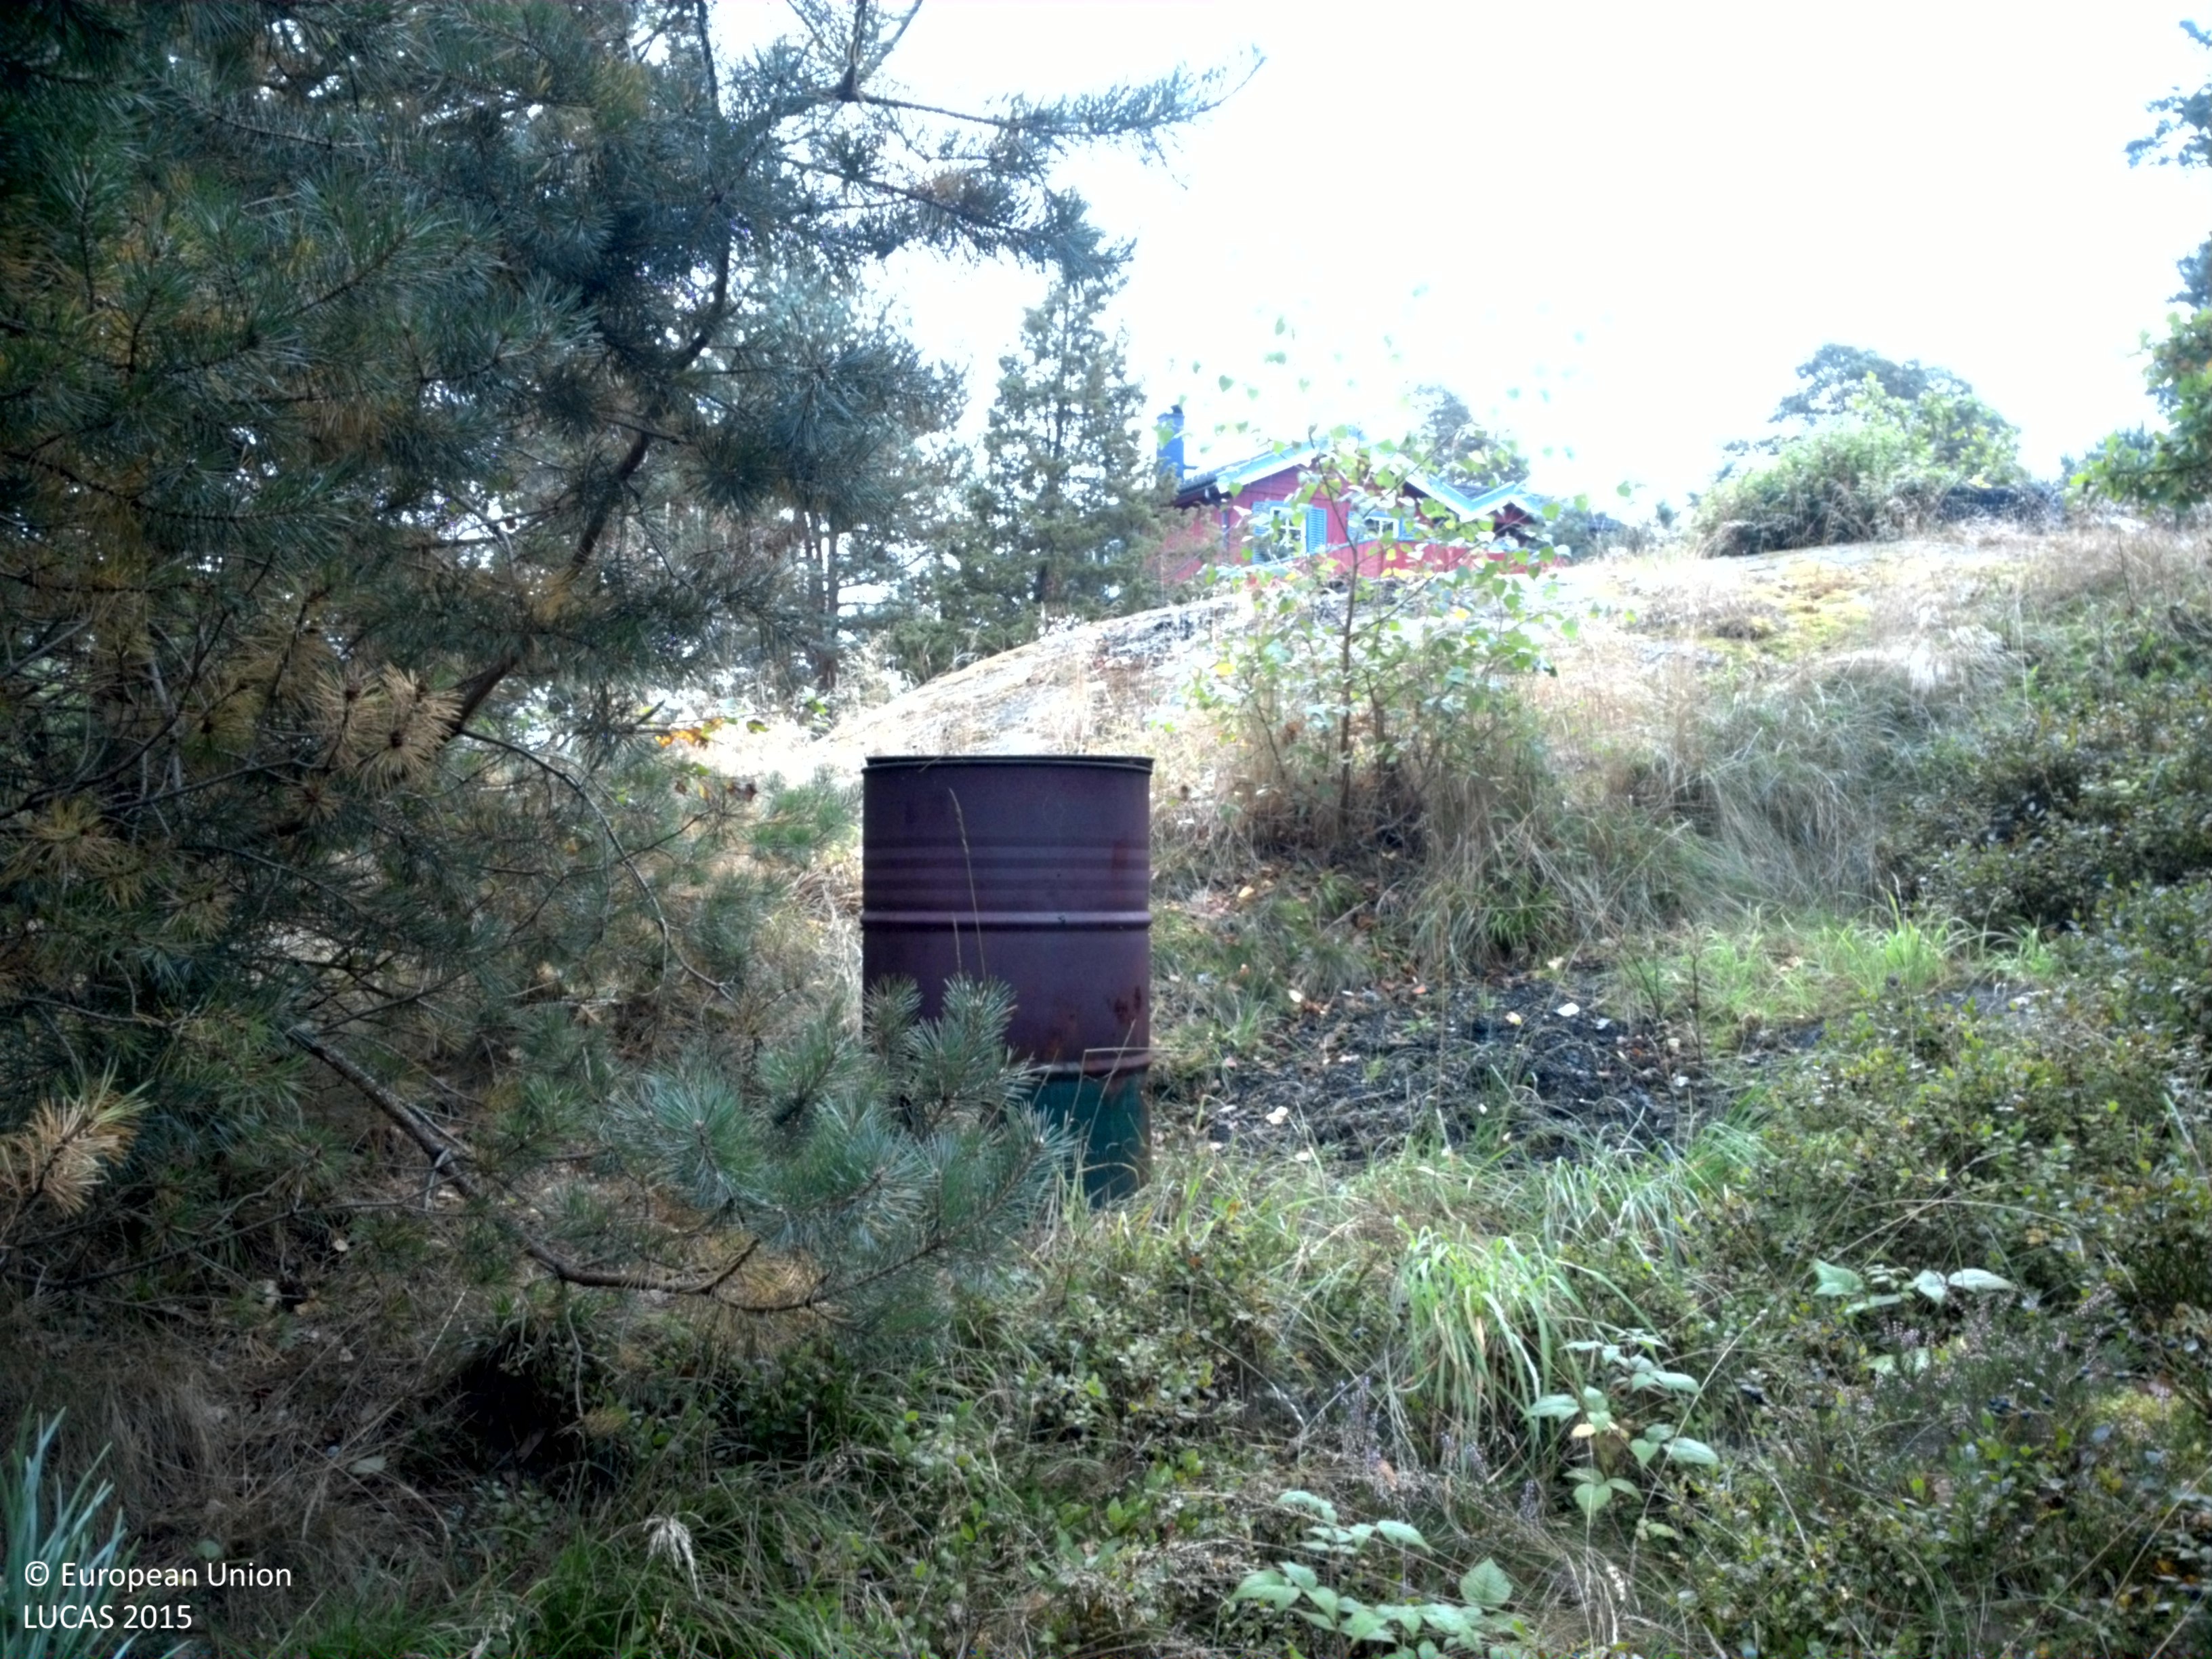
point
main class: Woodland
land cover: Pine dominated mixed woodland
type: boreal forest
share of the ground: < 10 %
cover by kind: lichens and mosses 35 %, consolidated bare surface 20 %, coniferous forest trees 15 %, shrubs 15 %, herbaceous plants 10 %, broadleaved forest trees 5 %
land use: Residential
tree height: > 5 m
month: September
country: SE
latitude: 59.3695
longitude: 18.6768
